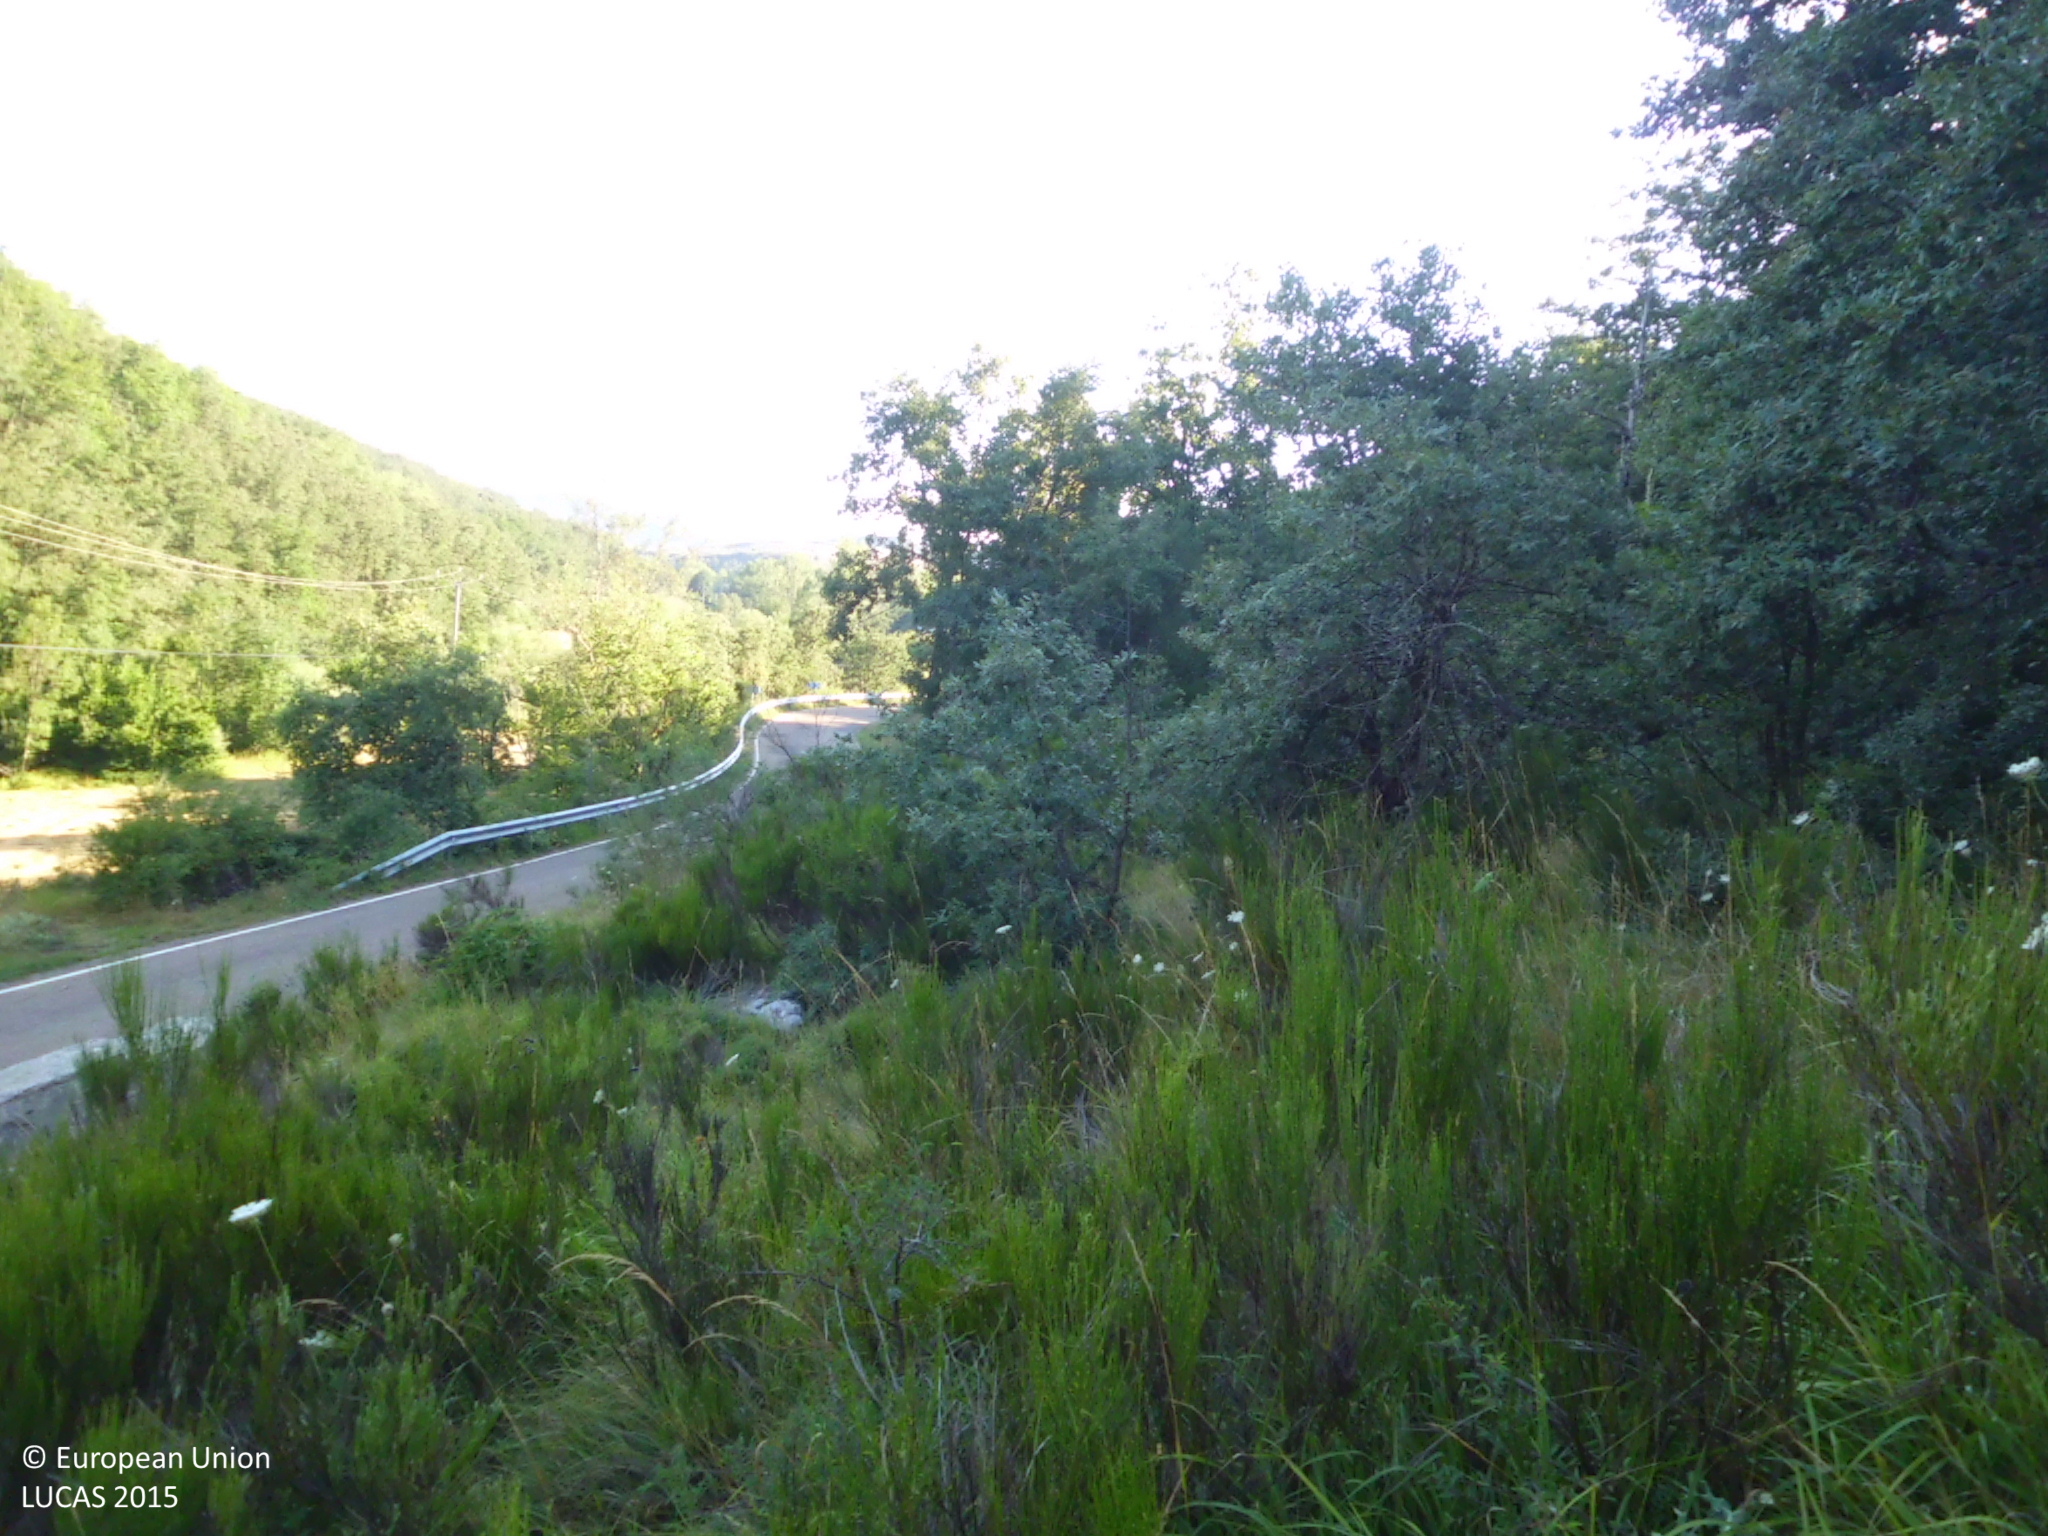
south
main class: Shrubland
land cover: Shrubland with sparse tree cover
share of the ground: 25 - 50 %
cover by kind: herbaceous plants 55 %, shrubs 40 %, broadleaved forest trees 5 %
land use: Semi-natural and natural areas not in use
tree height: < 5 m
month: July
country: ES
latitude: 42.9049
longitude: -4.3709
